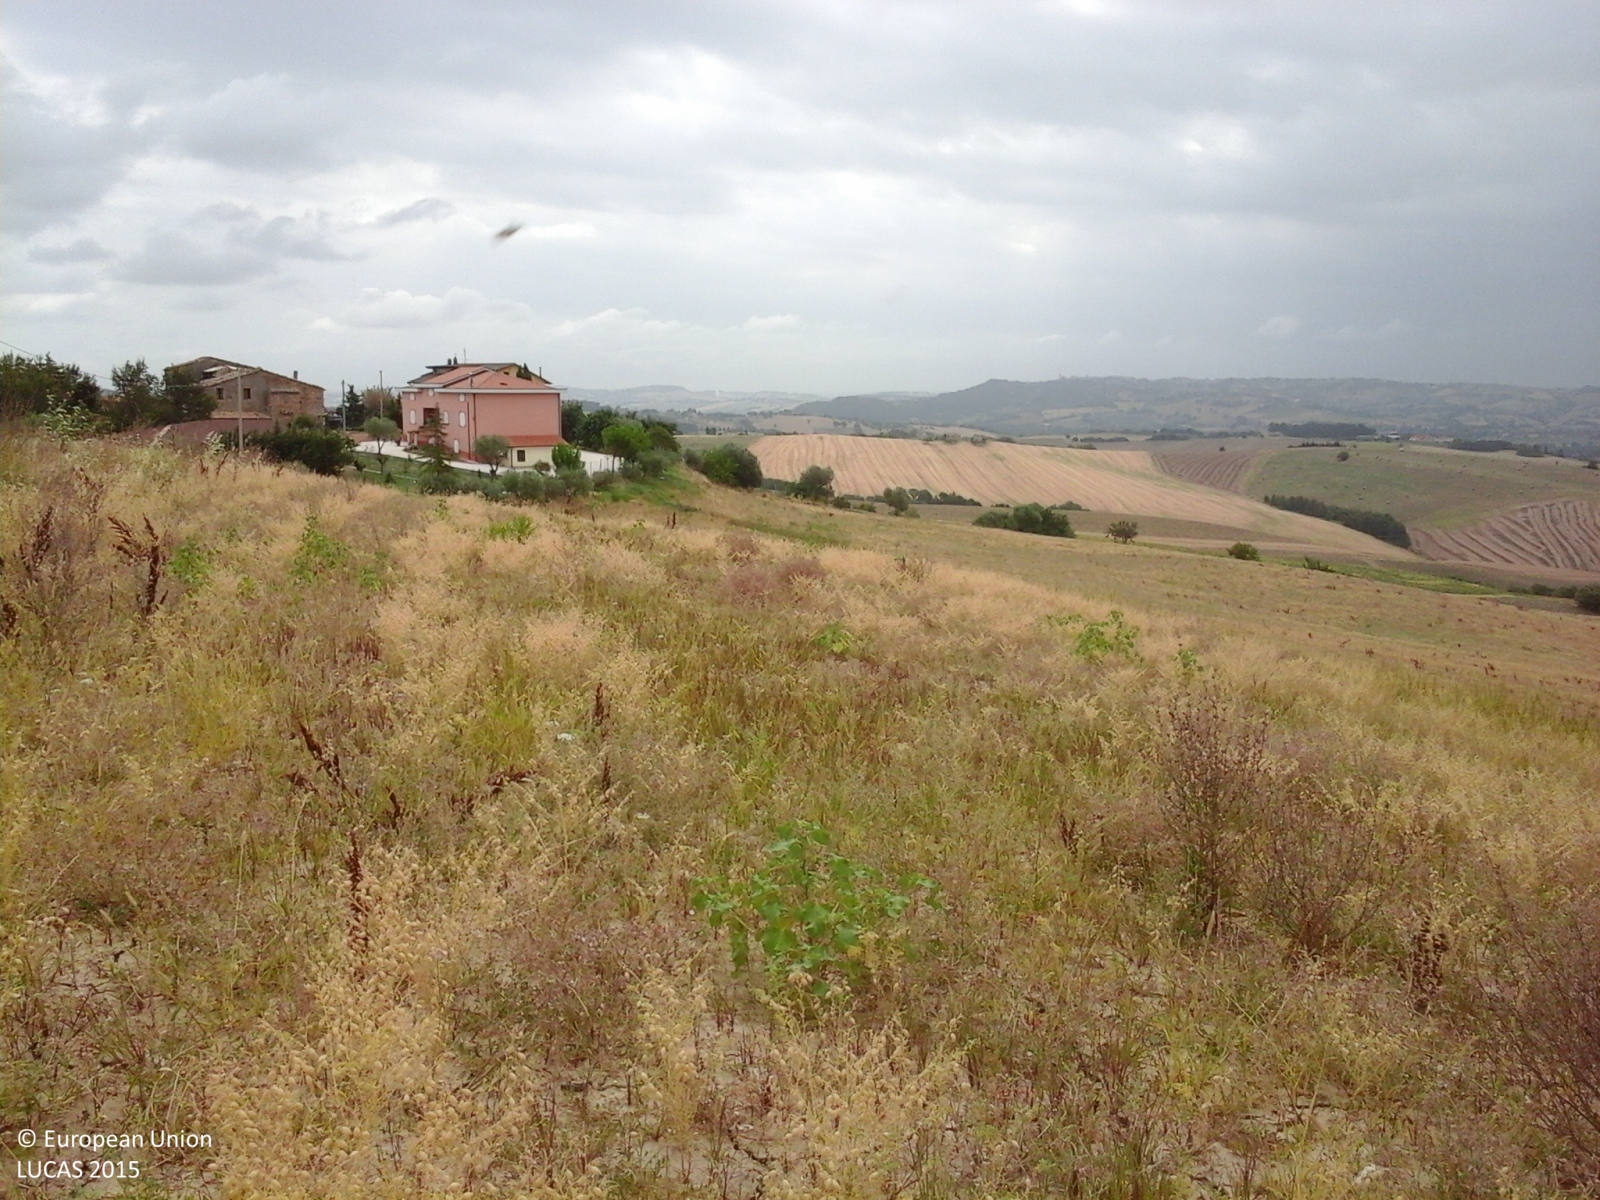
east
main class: Cropland
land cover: Dry pulses
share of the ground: > 75 %
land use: Agriculture (excluding fallow land and kitchen gardens)
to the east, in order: Dry pulses; Lines of trees; Other fresh vegetables; Olive groves; Grassland with sparse tree/shrub cover
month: July
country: IT
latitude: 43.2883
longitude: 13.2575
